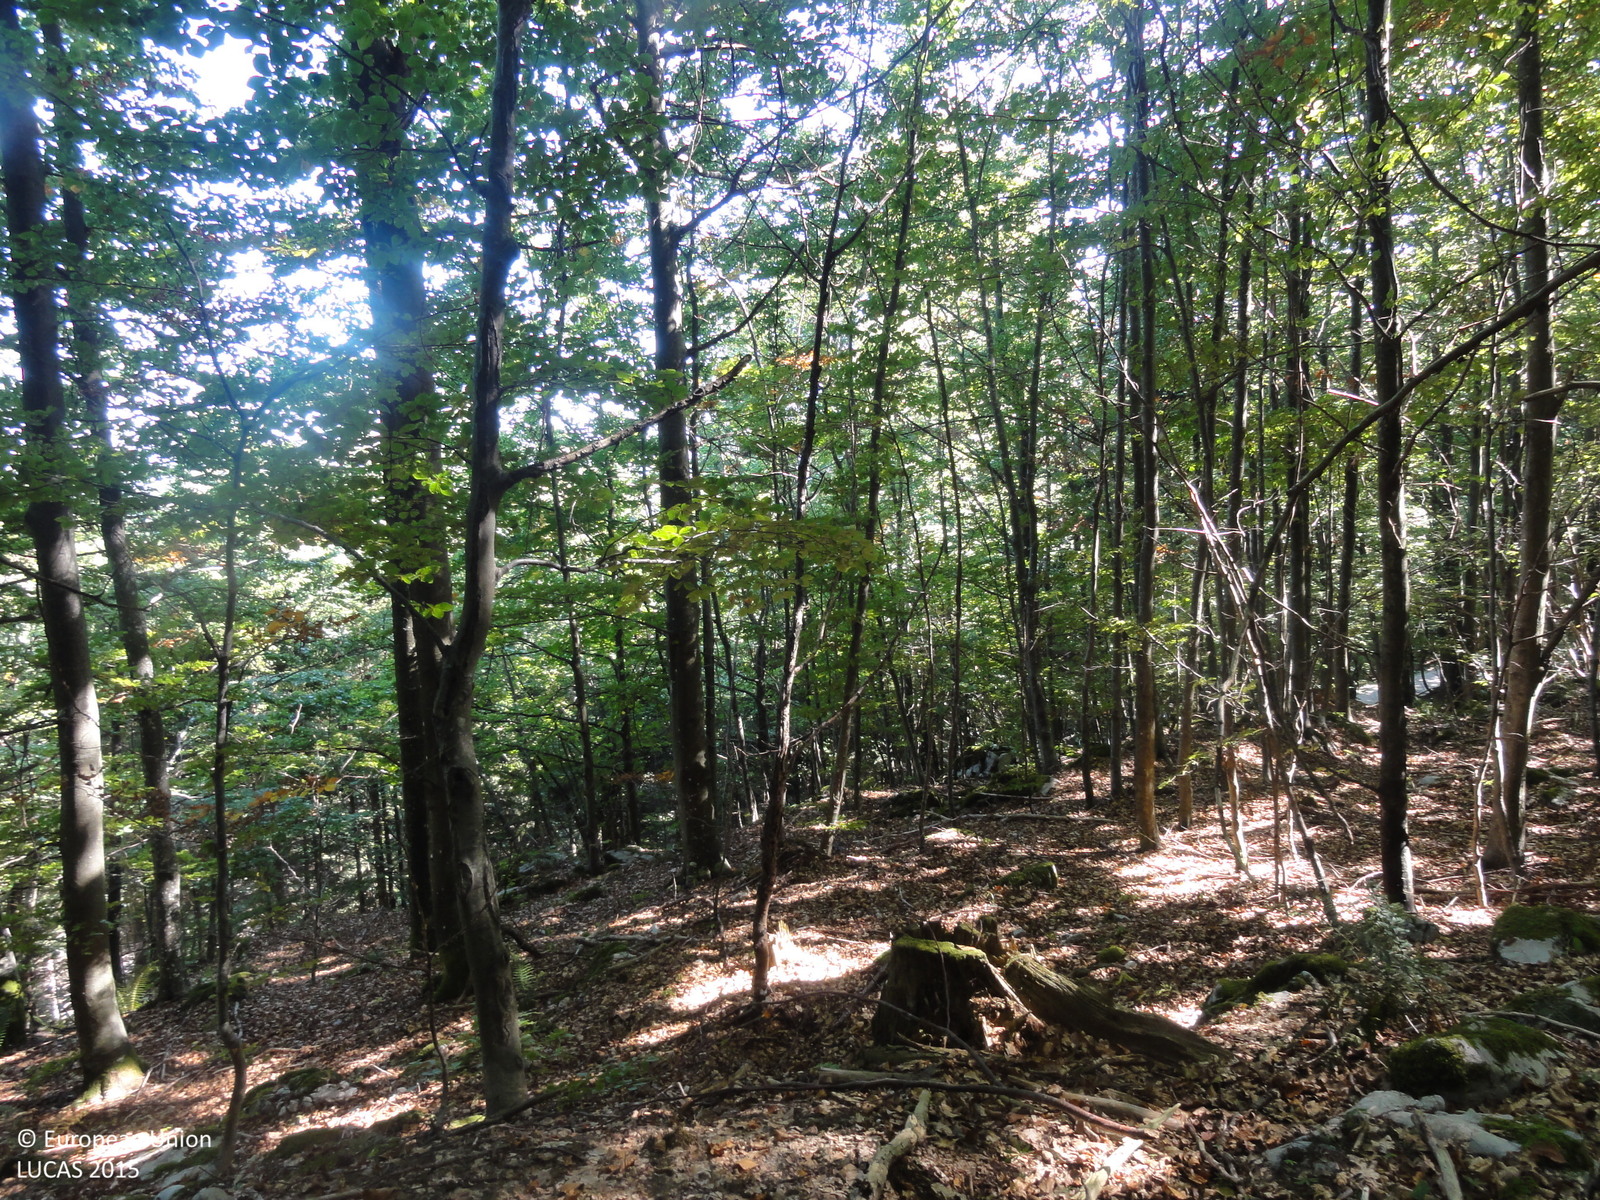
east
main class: Woodland
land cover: Broadleaved woodland
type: beech forest
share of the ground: > 75 %
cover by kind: broadleaved forest trees 90 %, coniferous forest trees 5 %, unconsolidated bare surface 5 %
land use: Forestry
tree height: > 5 m
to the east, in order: Broadleaved woodland; Tracks; Spruce dominated mixed woodland; Broadleaved woodland
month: September
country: SI
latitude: 45.7652
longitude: 14.9981
